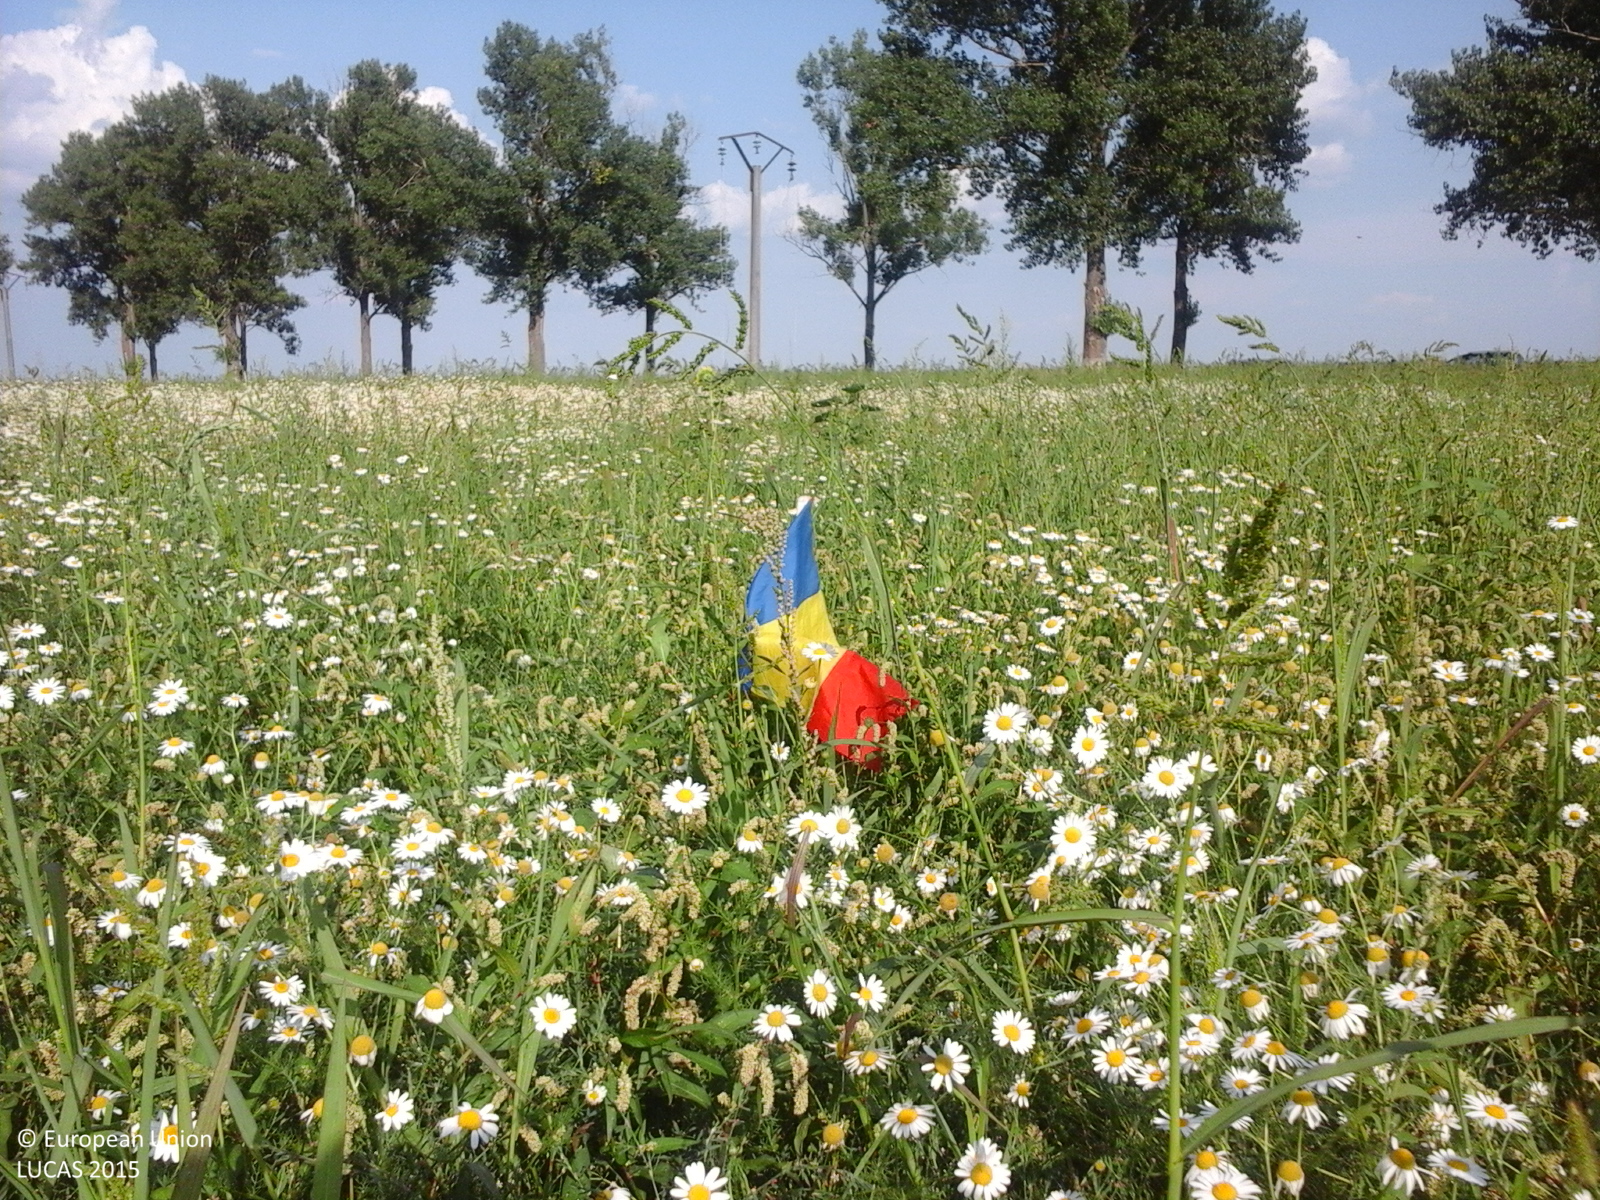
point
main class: Grassland
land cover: Grassland without tree/shrub cover
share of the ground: > 75 %
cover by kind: herbaceous plants 100 %
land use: Agriculture (excluding fallow land and kitchen gardens)
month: July
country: RO
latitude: 44.0649
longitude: 25.8124
